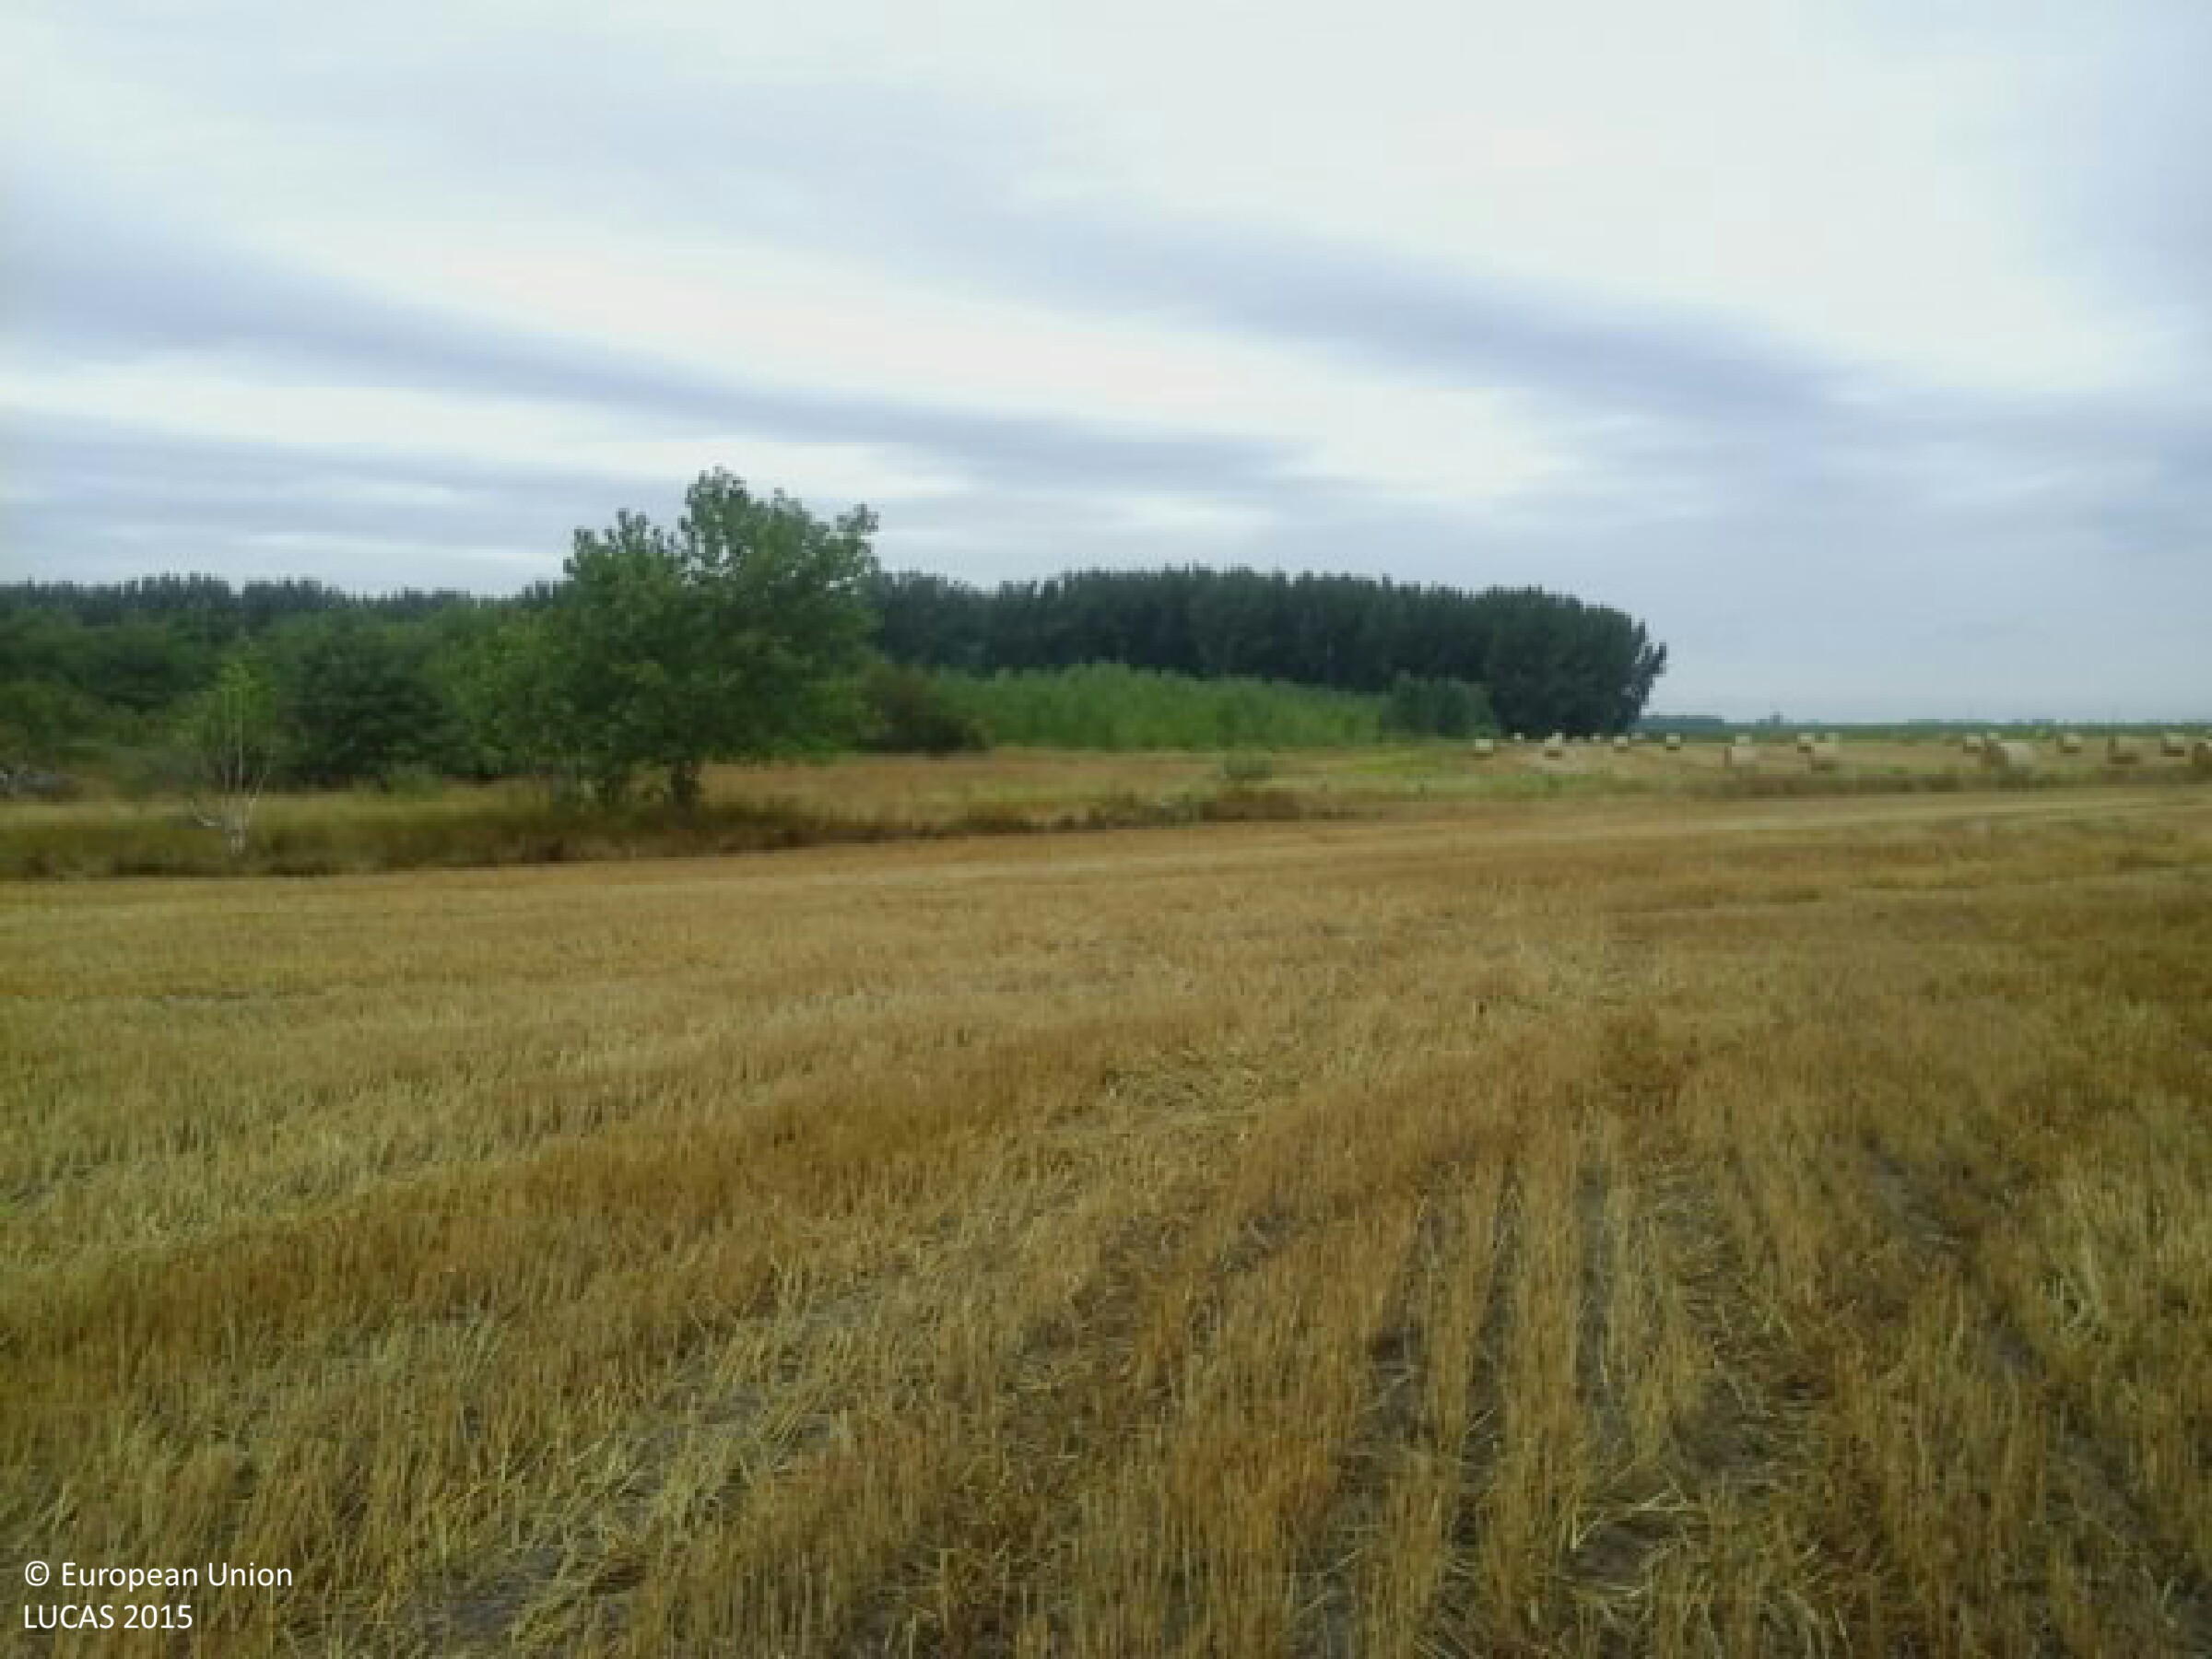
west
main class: Cropland
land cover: Common wheat
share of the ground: 25 - 50 %
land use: Agriculture (excluding fallow land and kitchen gardens)
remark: Harvested field
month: July
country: HU
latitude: 46.9534
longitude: 19.7846
